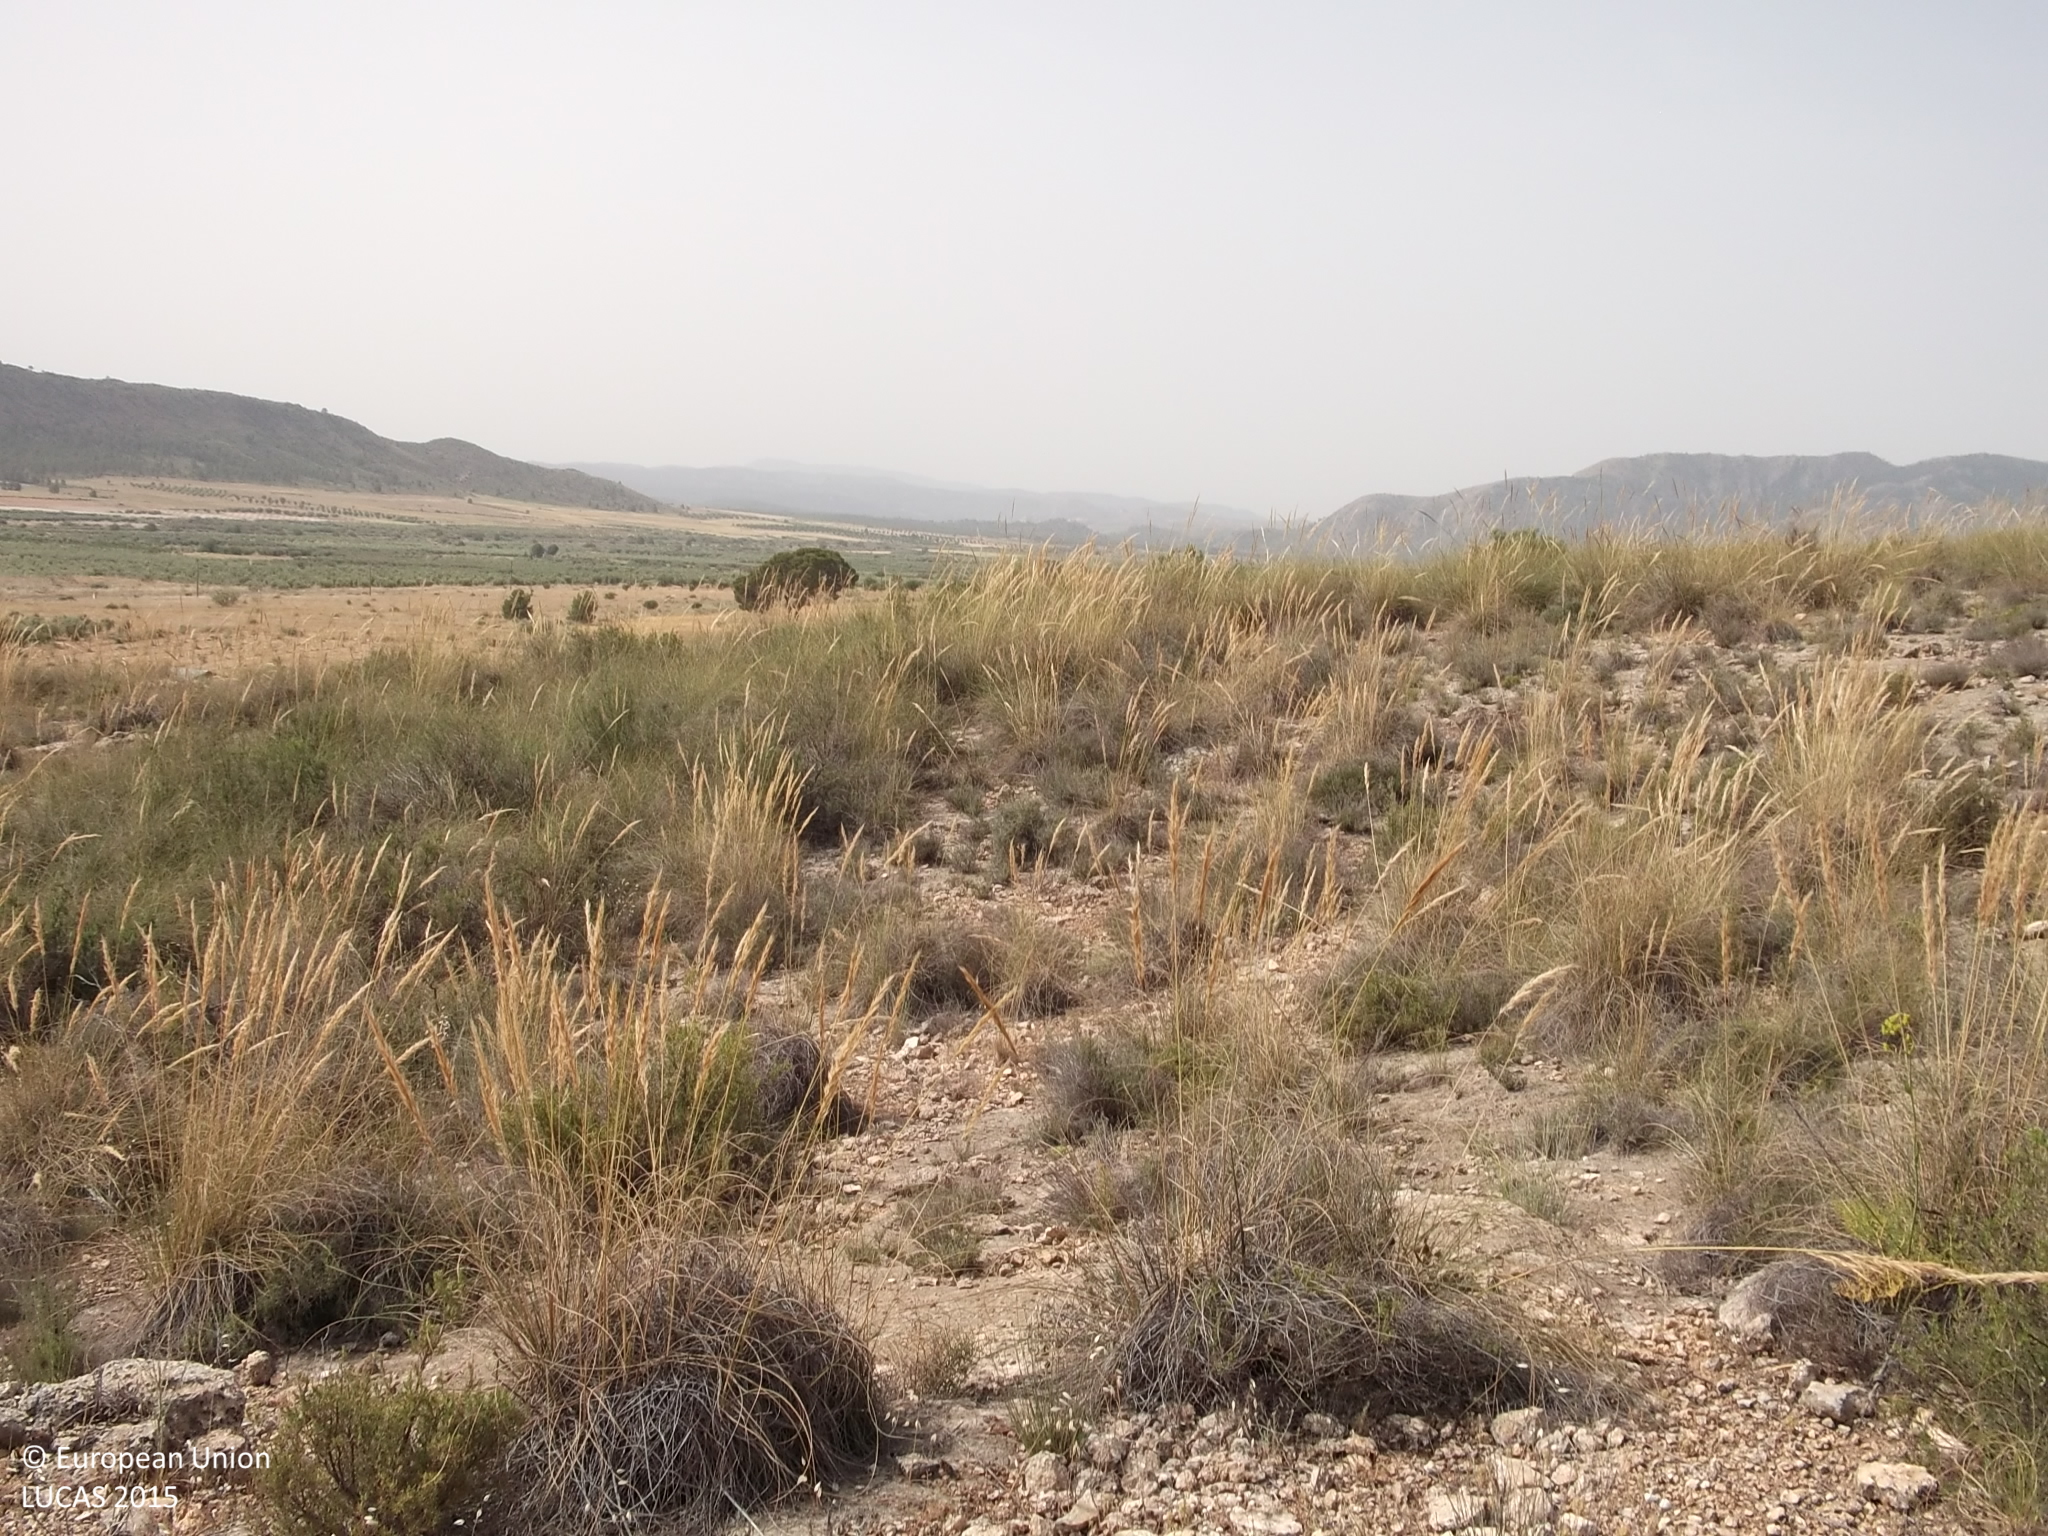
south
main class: Shrubland
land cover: Shrubland without tree cover
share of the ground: 25 - 50 %
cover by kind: consolidated bare surface 50 %, shrubs 25 %, herbaceous plants 25 %
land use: Semi-natural and natural areas not in use
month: May
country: ES
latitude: 38.4413
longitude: -1.6209
